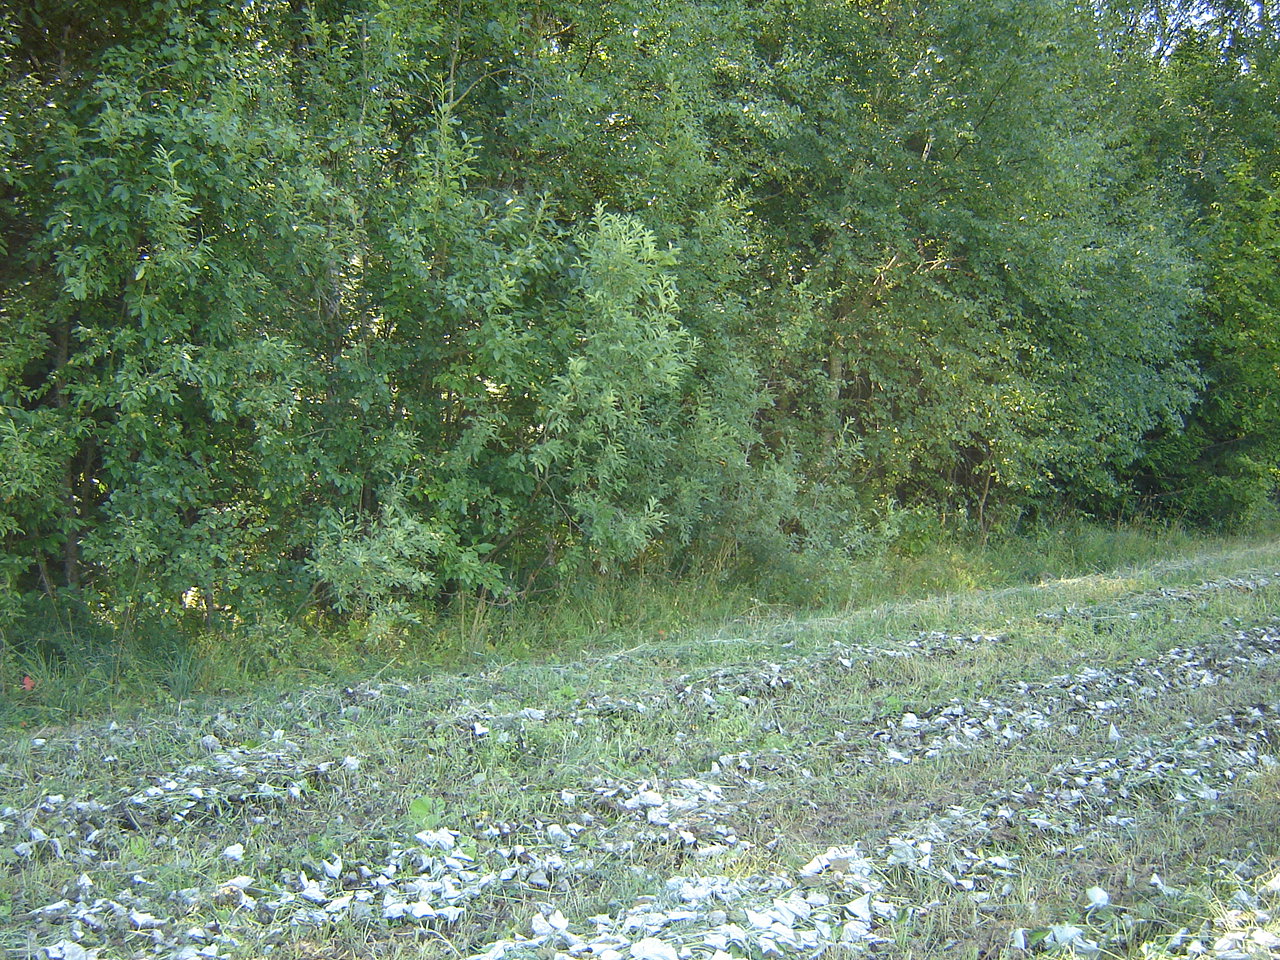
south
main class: Grassland
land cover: Grassland without tree/shrub cover
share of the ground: > 75 %
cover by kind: herbaceous plants 100 %
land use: Agriculture (excluding fallow land and kitchen gardens)
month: August
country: LT
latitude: 55.2078
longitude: 24.9942
